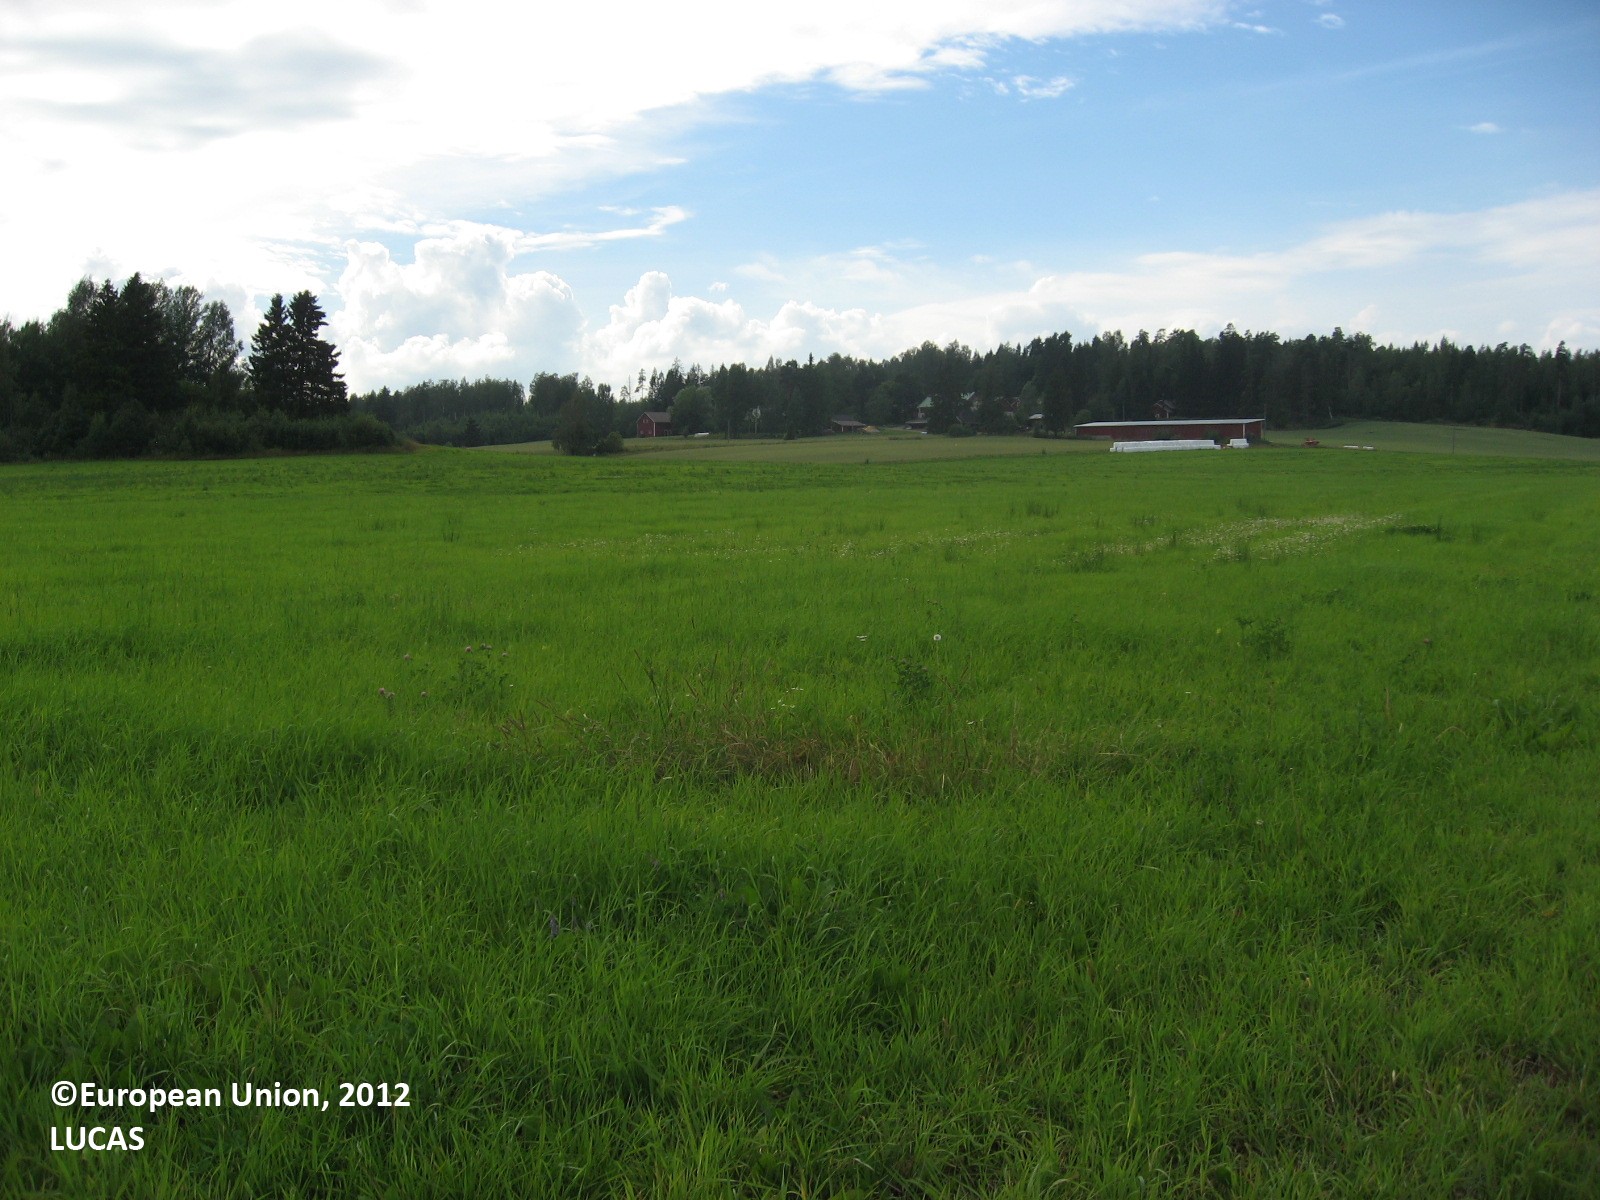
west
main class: Cropland
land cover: Temporary grasslands
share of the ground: > 75 %
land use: Agriculture (excluding fallow land and kitchen gardens)
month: August
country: FI
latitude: 60.3858
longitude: 25.3102
